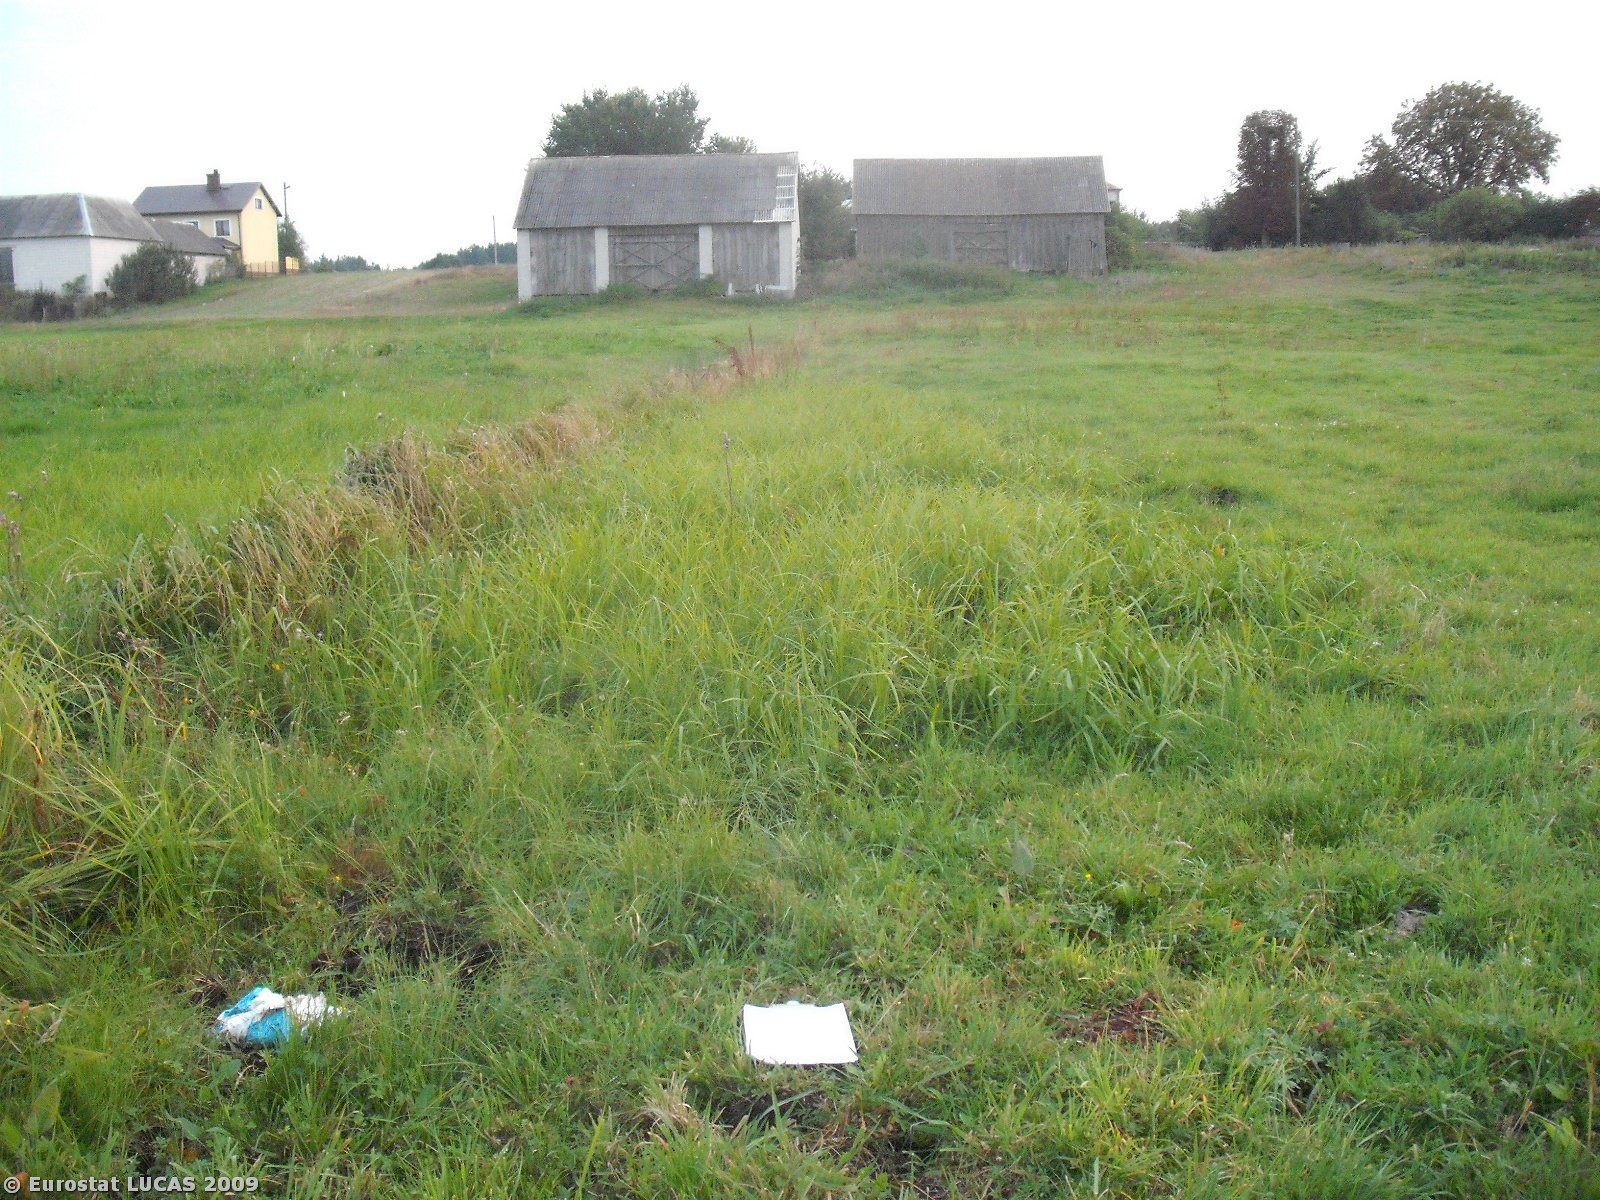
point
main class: Grassland
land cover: Grassland without tree/shrub cover
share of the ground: > 75 %
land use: Agriculture (excluding fallow land and kitchen gardens)
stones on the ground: < 10 %
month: September
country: PL
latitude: 51.7883
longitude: 22.1369
